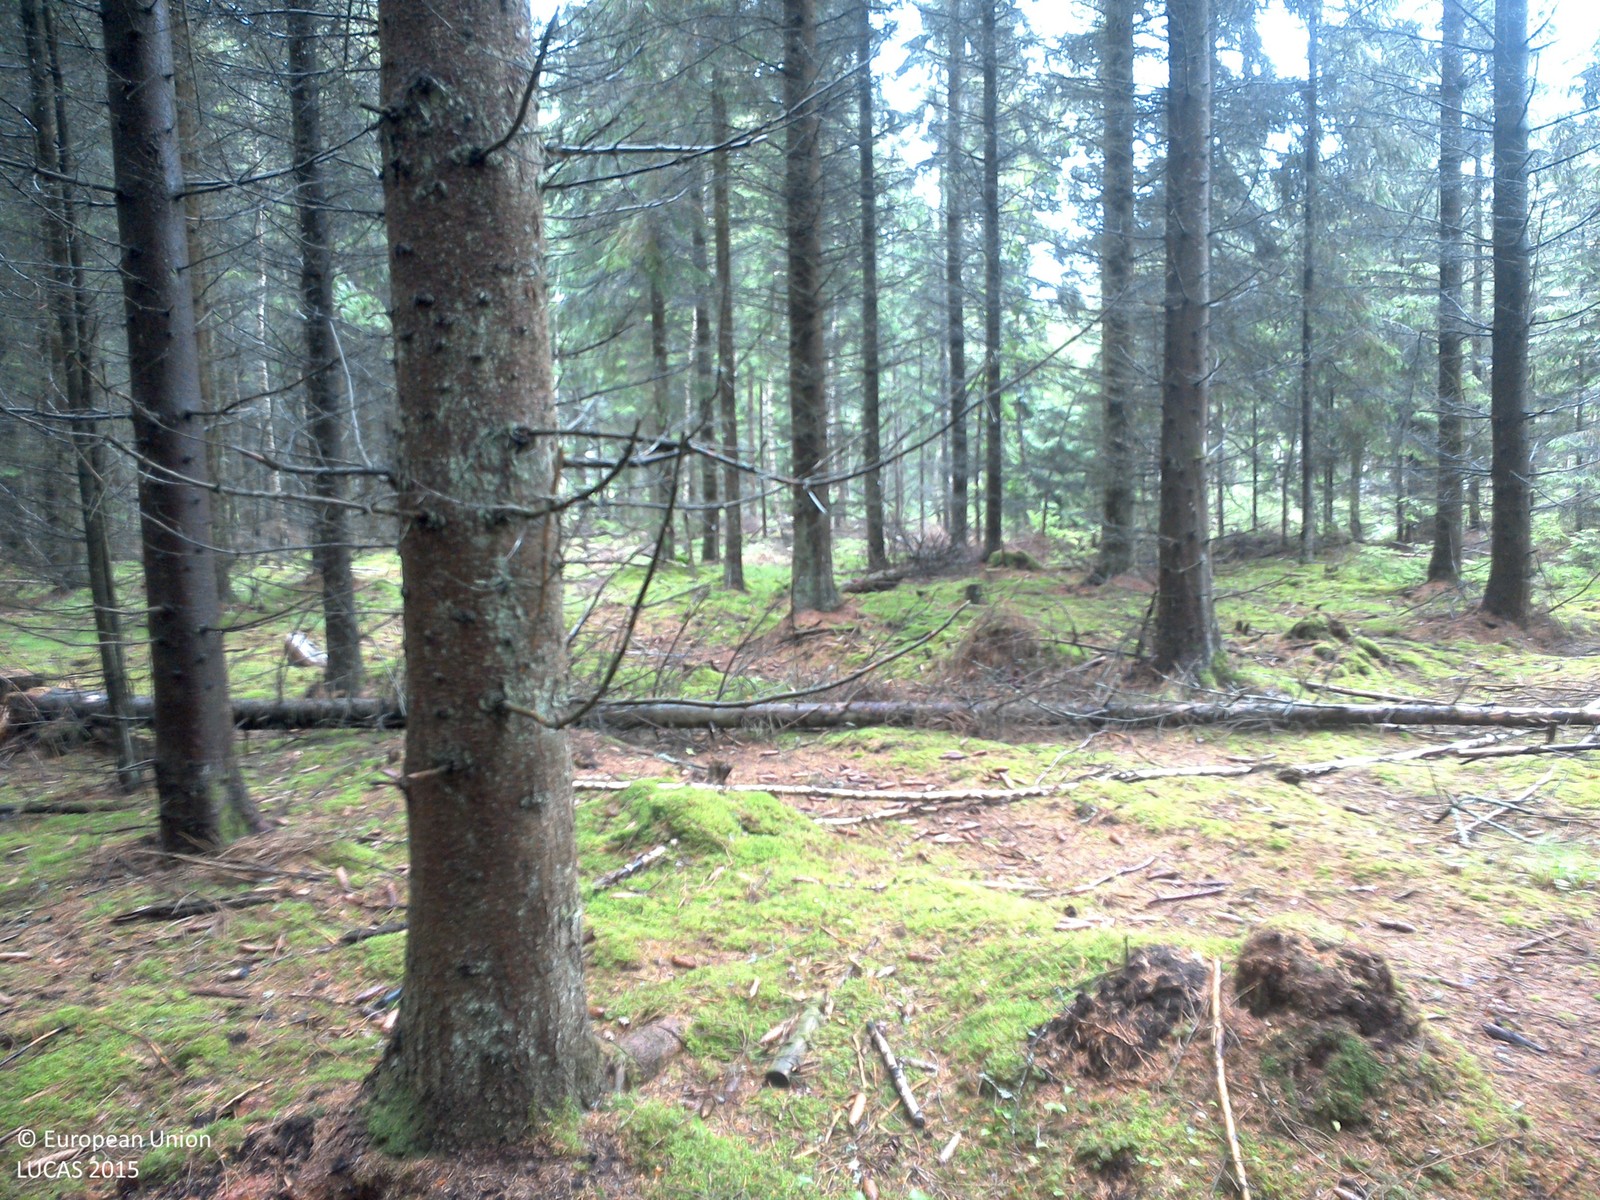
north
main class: Woodland
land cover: Spruce dominated coniferous woodland
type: boreal forest
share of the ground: 50 - 75 %
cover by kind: coniferous forest trees 70 %, lichens and mosses 30 %
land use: Forestry
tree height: > 5 m
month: July
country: SE
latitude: 58.4889
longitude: 14.9511
